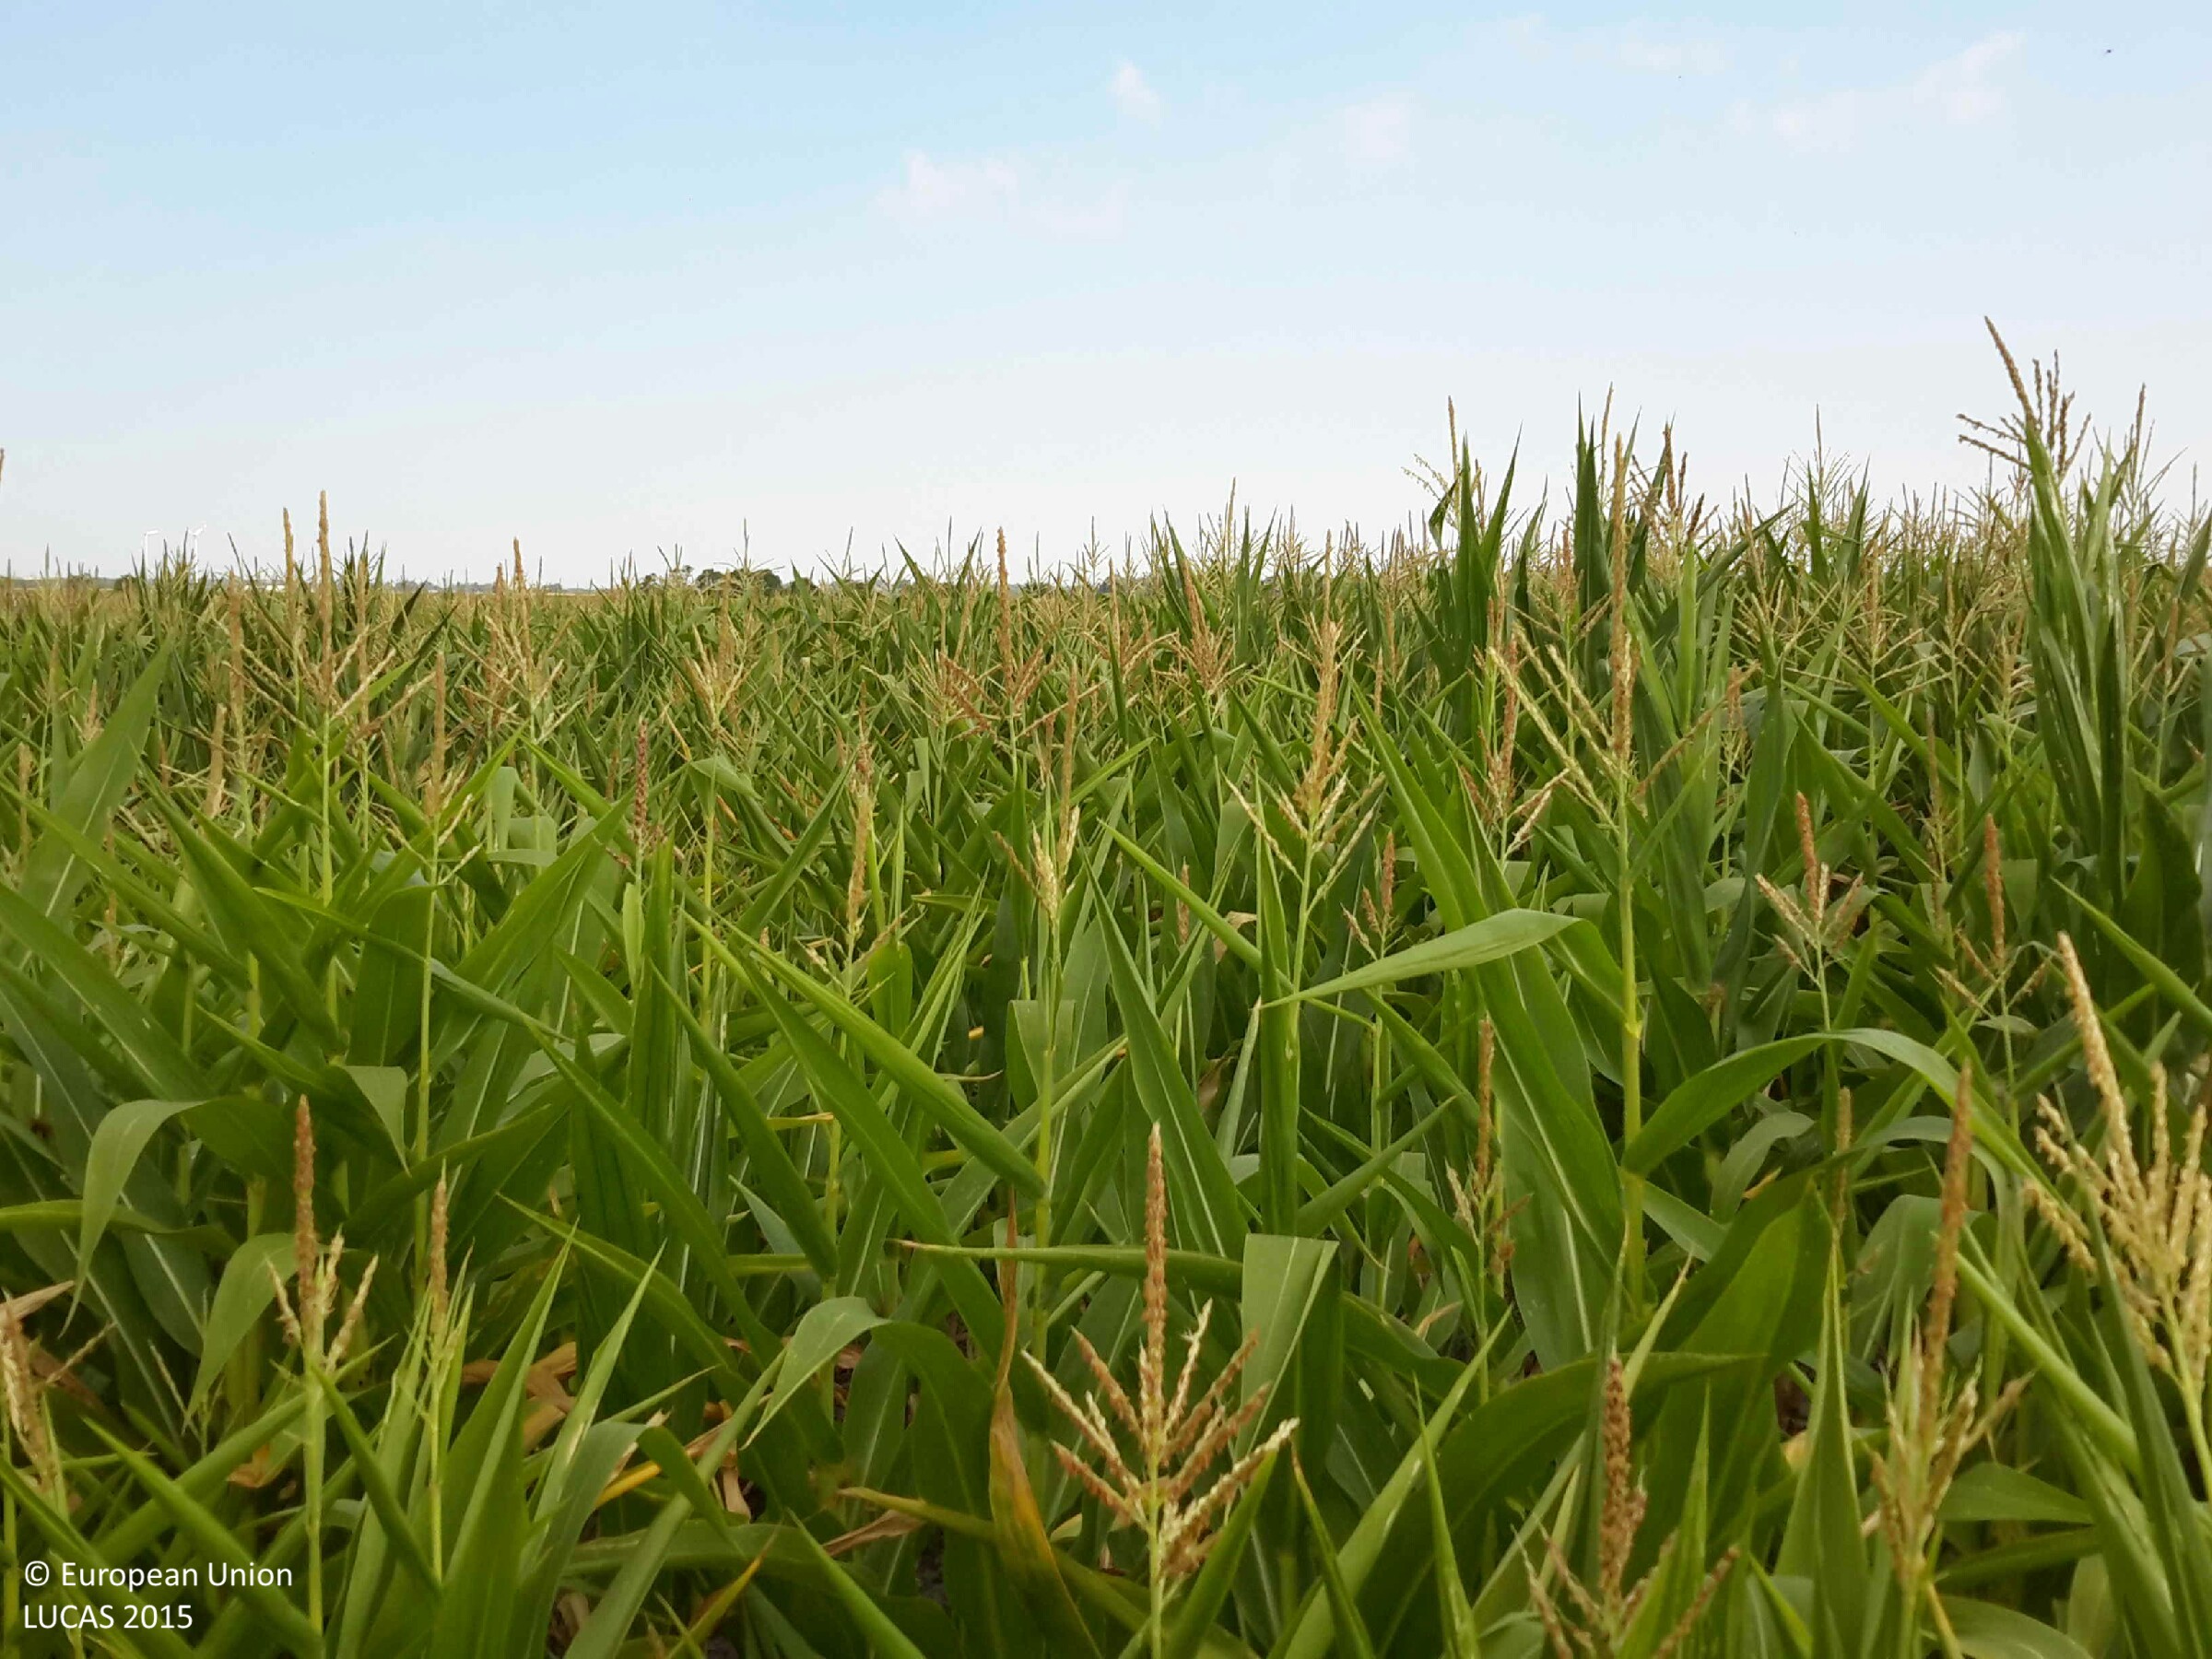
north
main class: Cropland
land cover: Maize
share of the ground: > 75 %
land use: Agriculture (excluding fallow land and kitchen gardens)
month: July
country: HU
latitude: 47.6124
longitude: 17.9263
